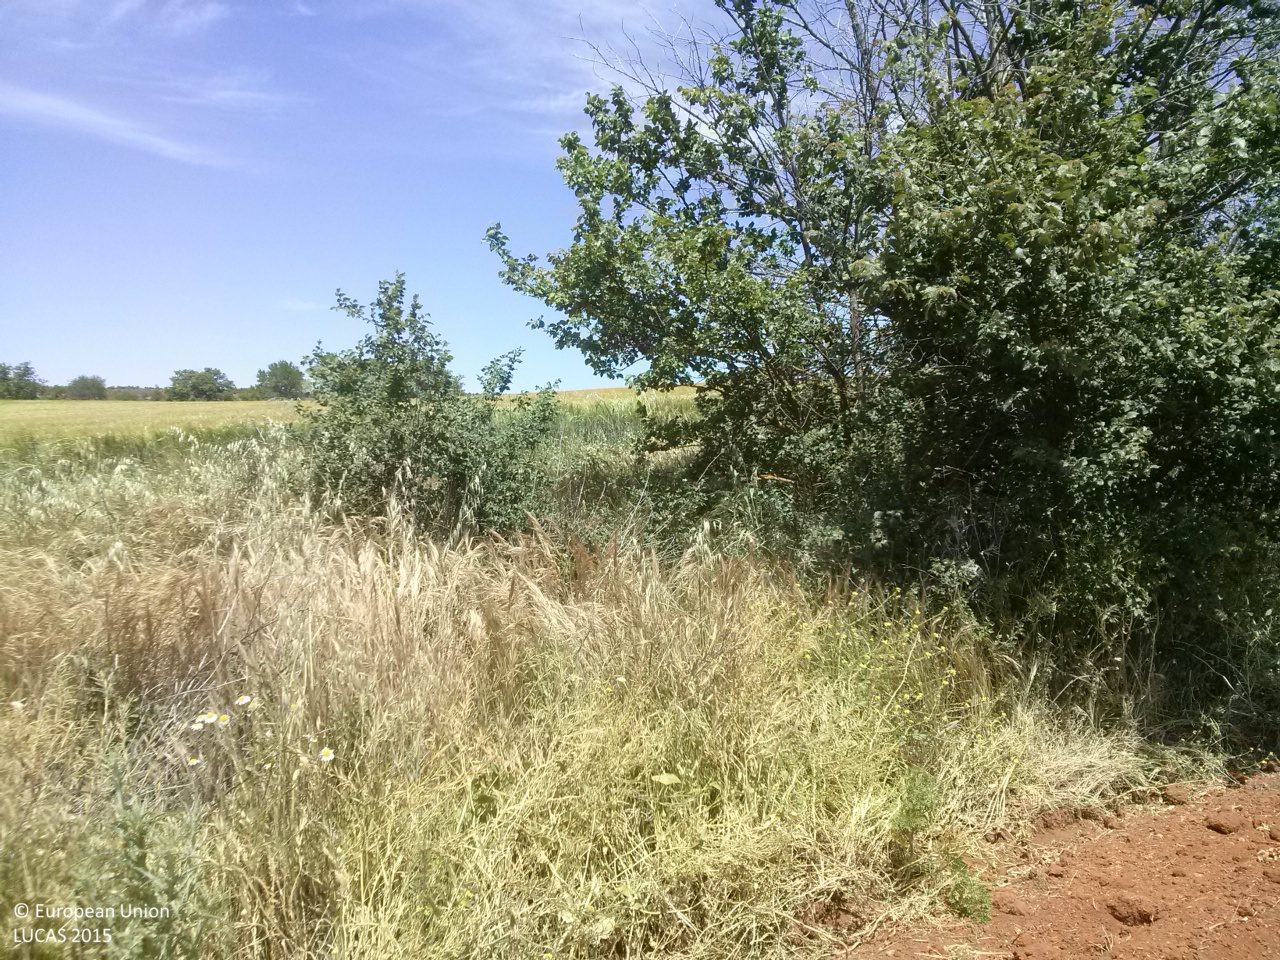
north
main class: Cropland
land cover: Sunflower
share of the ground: < 10 %
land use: Agriculture (excluding fallow land and kitchen gardens)
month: May
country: ES
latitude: 40.0428
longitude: -2.8329
